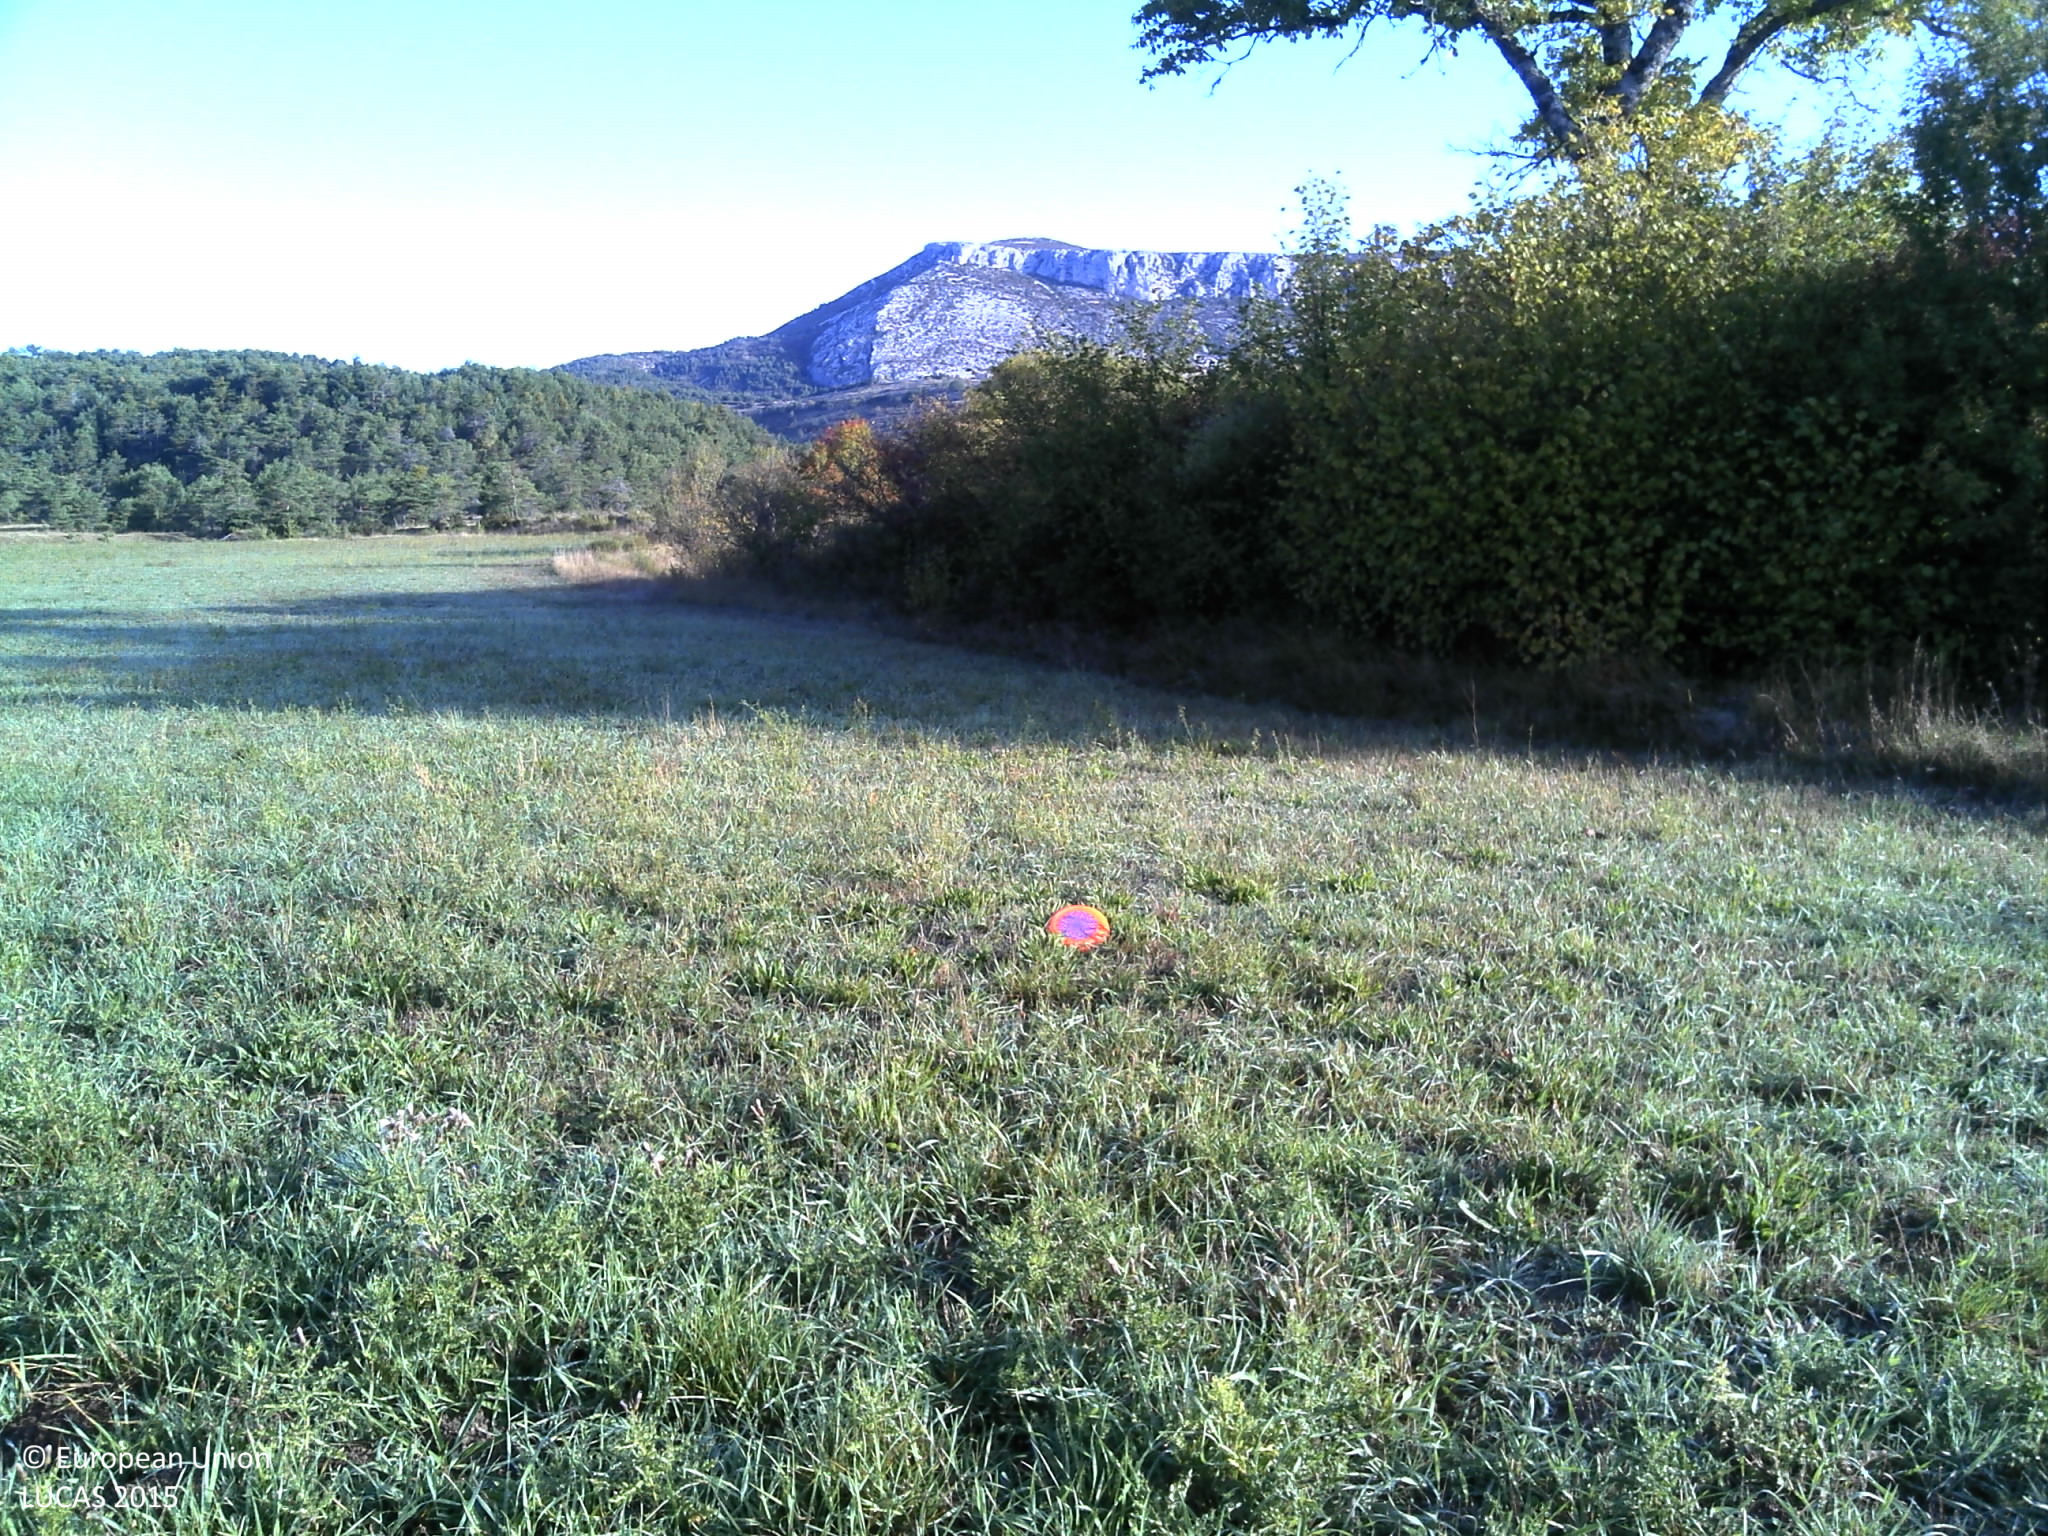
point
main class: Grassland
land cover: Grassland without tree/shrub cover
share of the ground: > 75 %
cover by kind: herbaceous plants 90 %, unconsolidated bare surface 10 %
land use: Agriculture (excluding fallow land and kitchen gardens)
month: September
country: FR
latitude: 43.7161
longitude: 6.5698
